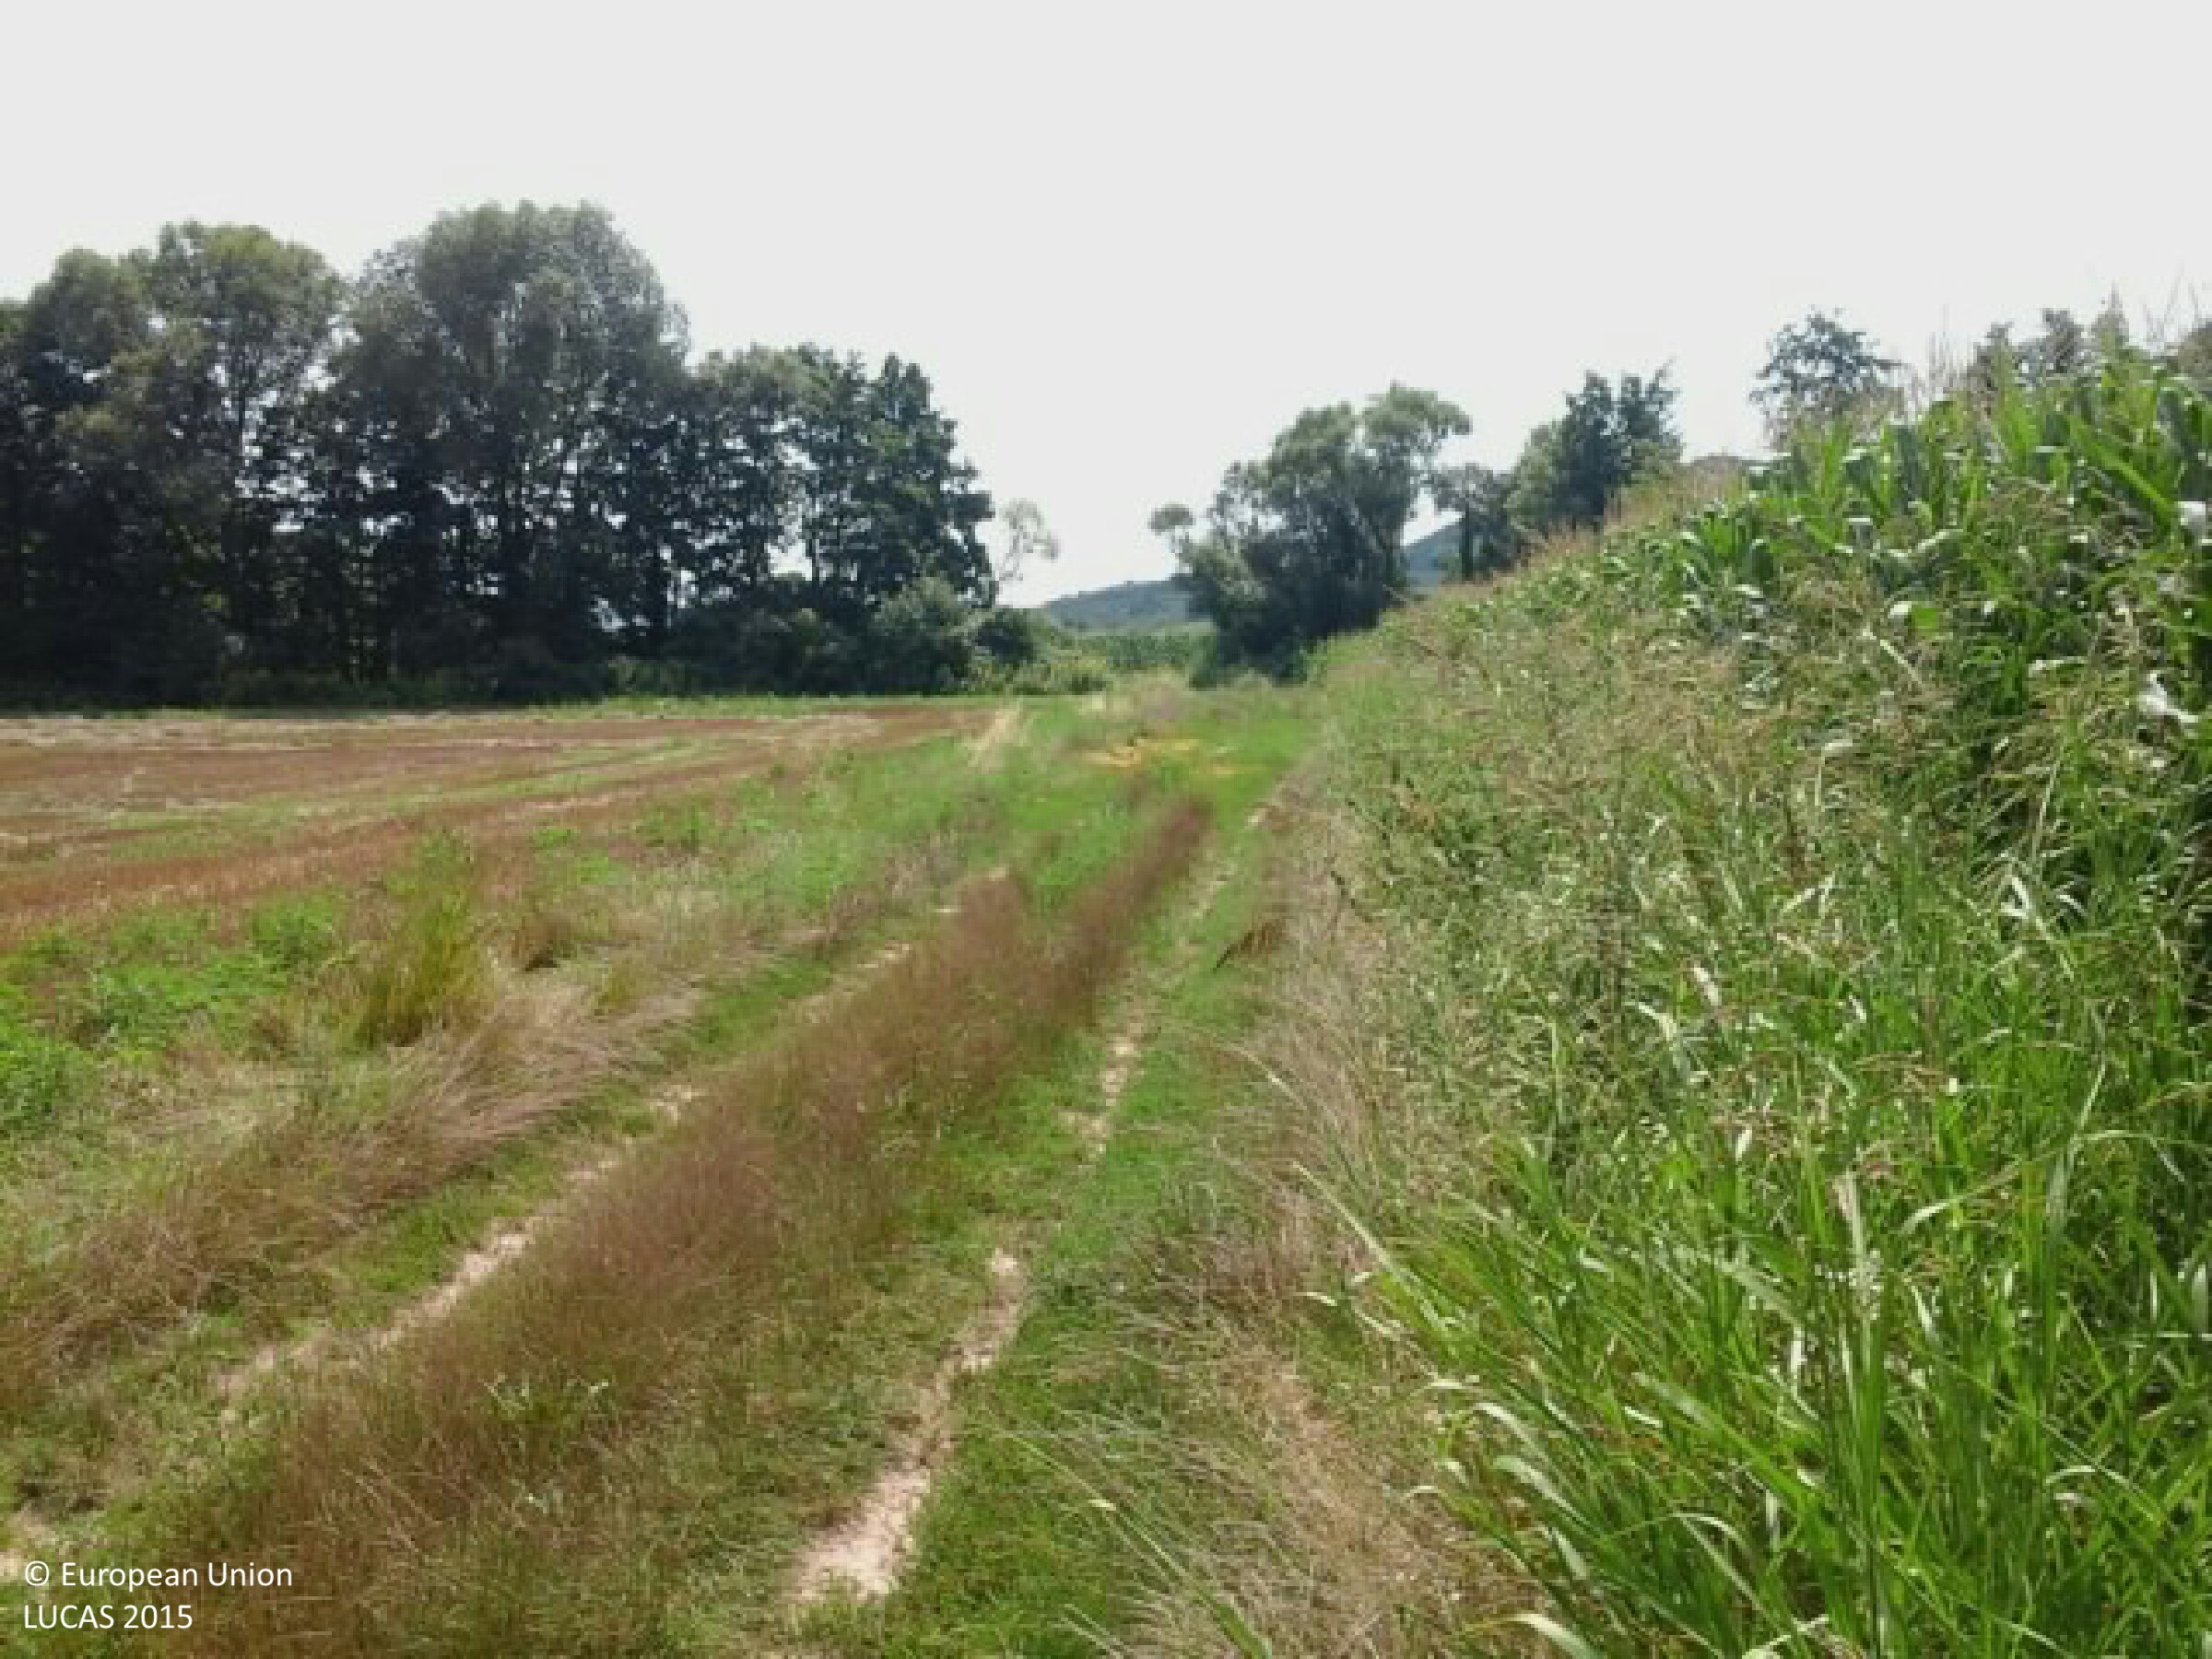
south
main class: Cropland
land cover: Maize
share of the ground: > 75 %
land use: Agriculture (excluding fallow land and kitchen gardens)
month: August
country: HU
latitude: 46.3448
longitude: 17.9455
